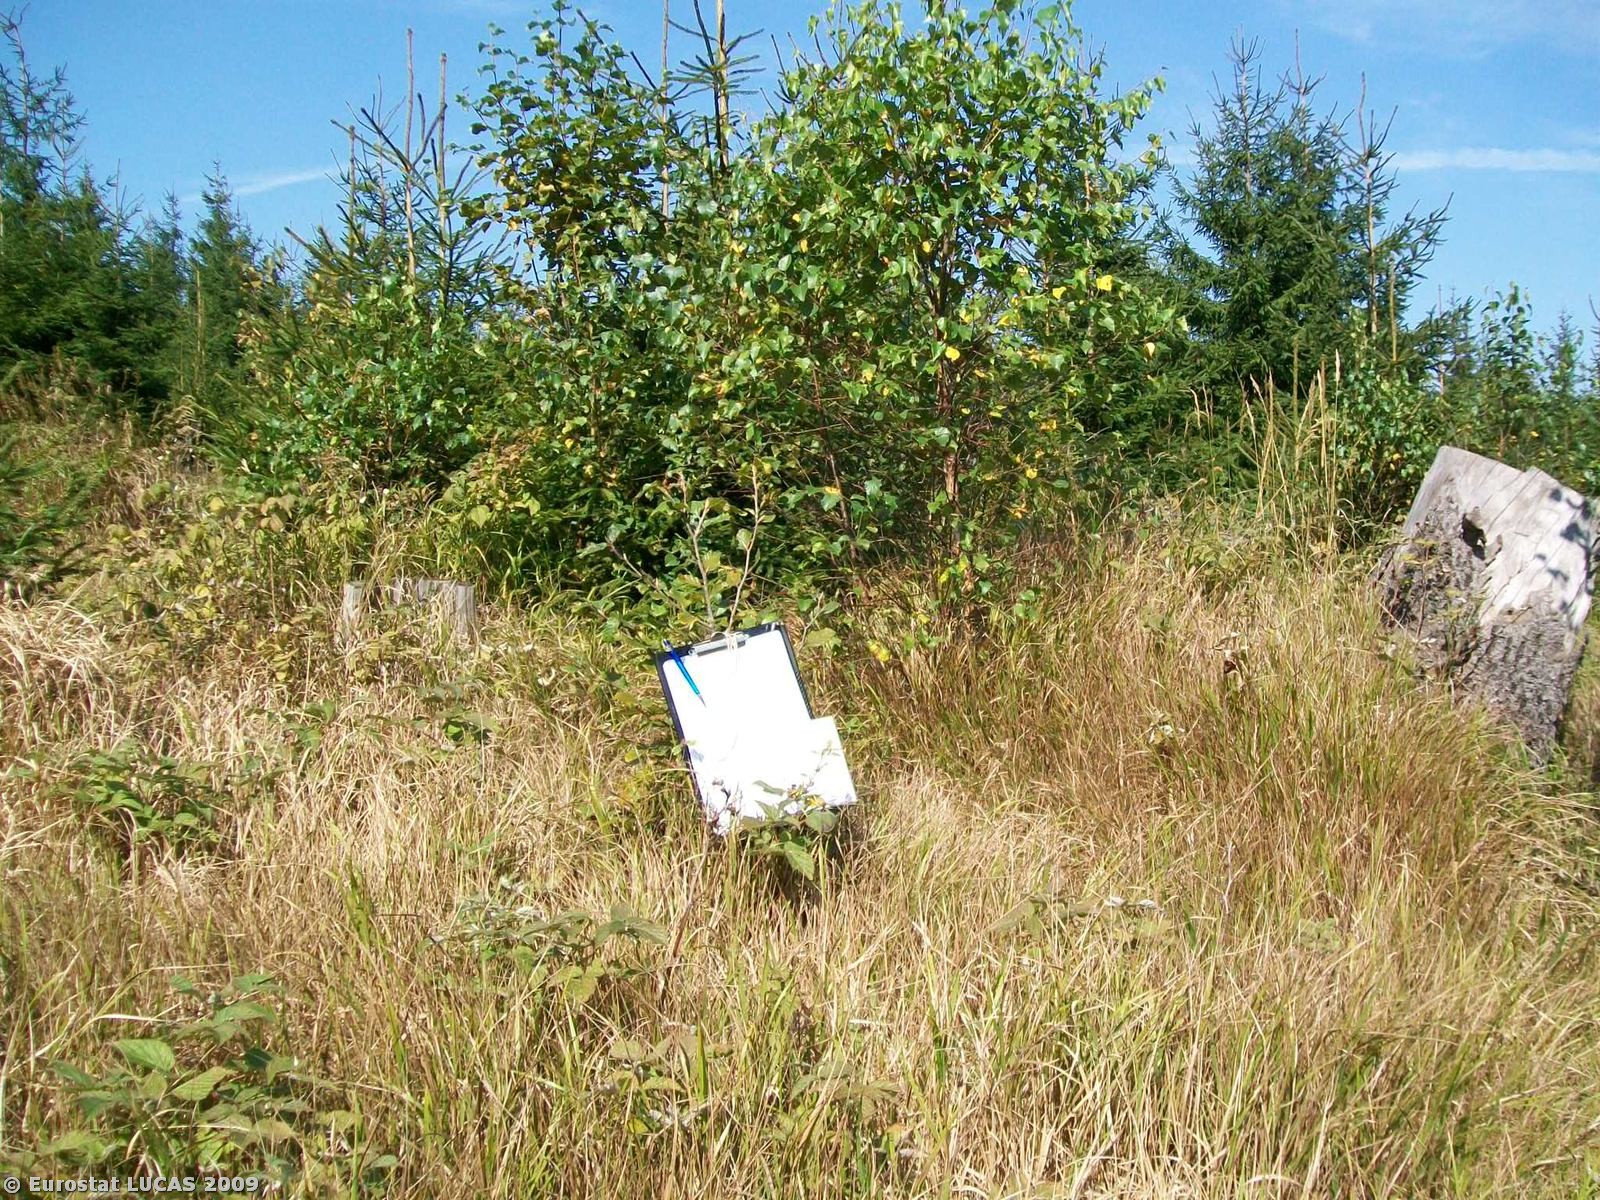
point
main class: Woodland
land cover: Mixed woodland
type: hemiboreal forest and nemoral coniferous forest and mixed broadleaved-coniferous forest
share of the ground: 50 - 75 %
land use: Forestry
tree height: > 5 m
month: September
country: PL
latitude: 50.1732
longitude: 16.6028
